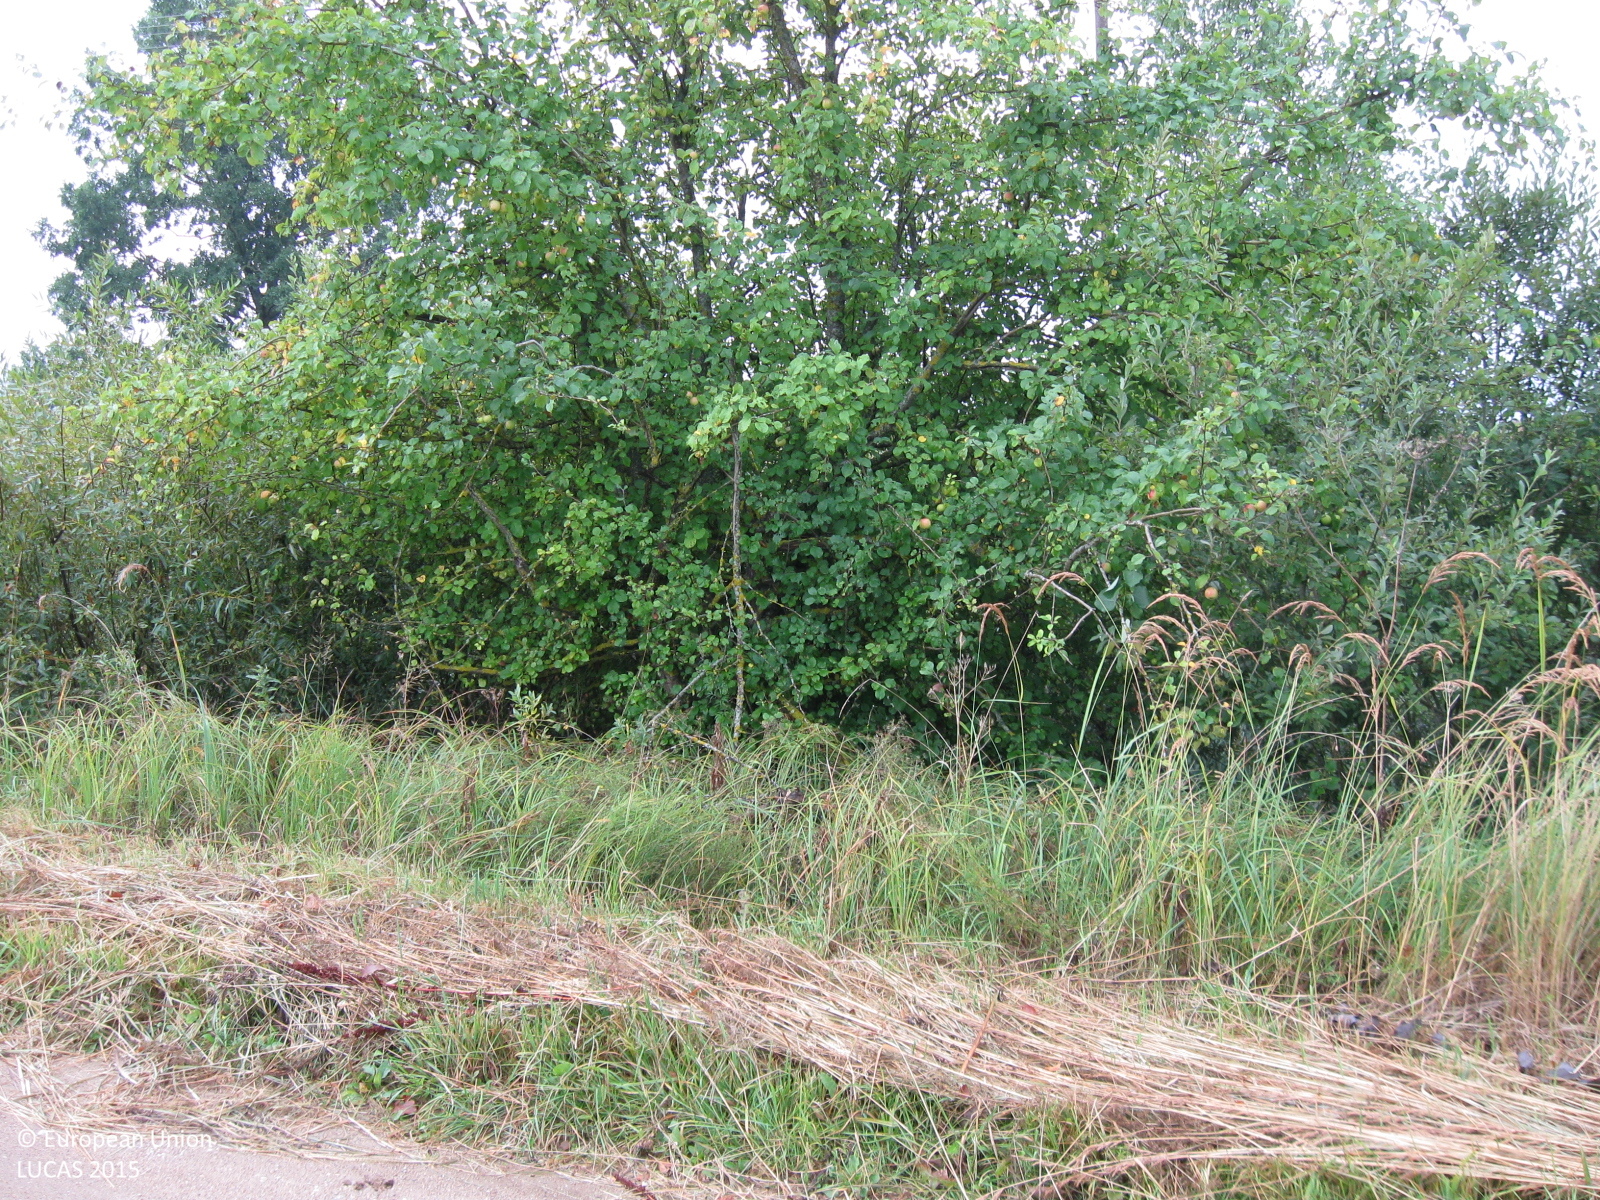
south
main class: Grassland
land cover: Spontaneously vegetated surfaces
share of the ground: > 75 %
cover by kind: herbaceous plants 95 %, consolidated bare surface 5 %
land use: Semi-natural and natural areas not in use
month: August
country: LT
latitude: 55.3453
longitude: 22.9525
